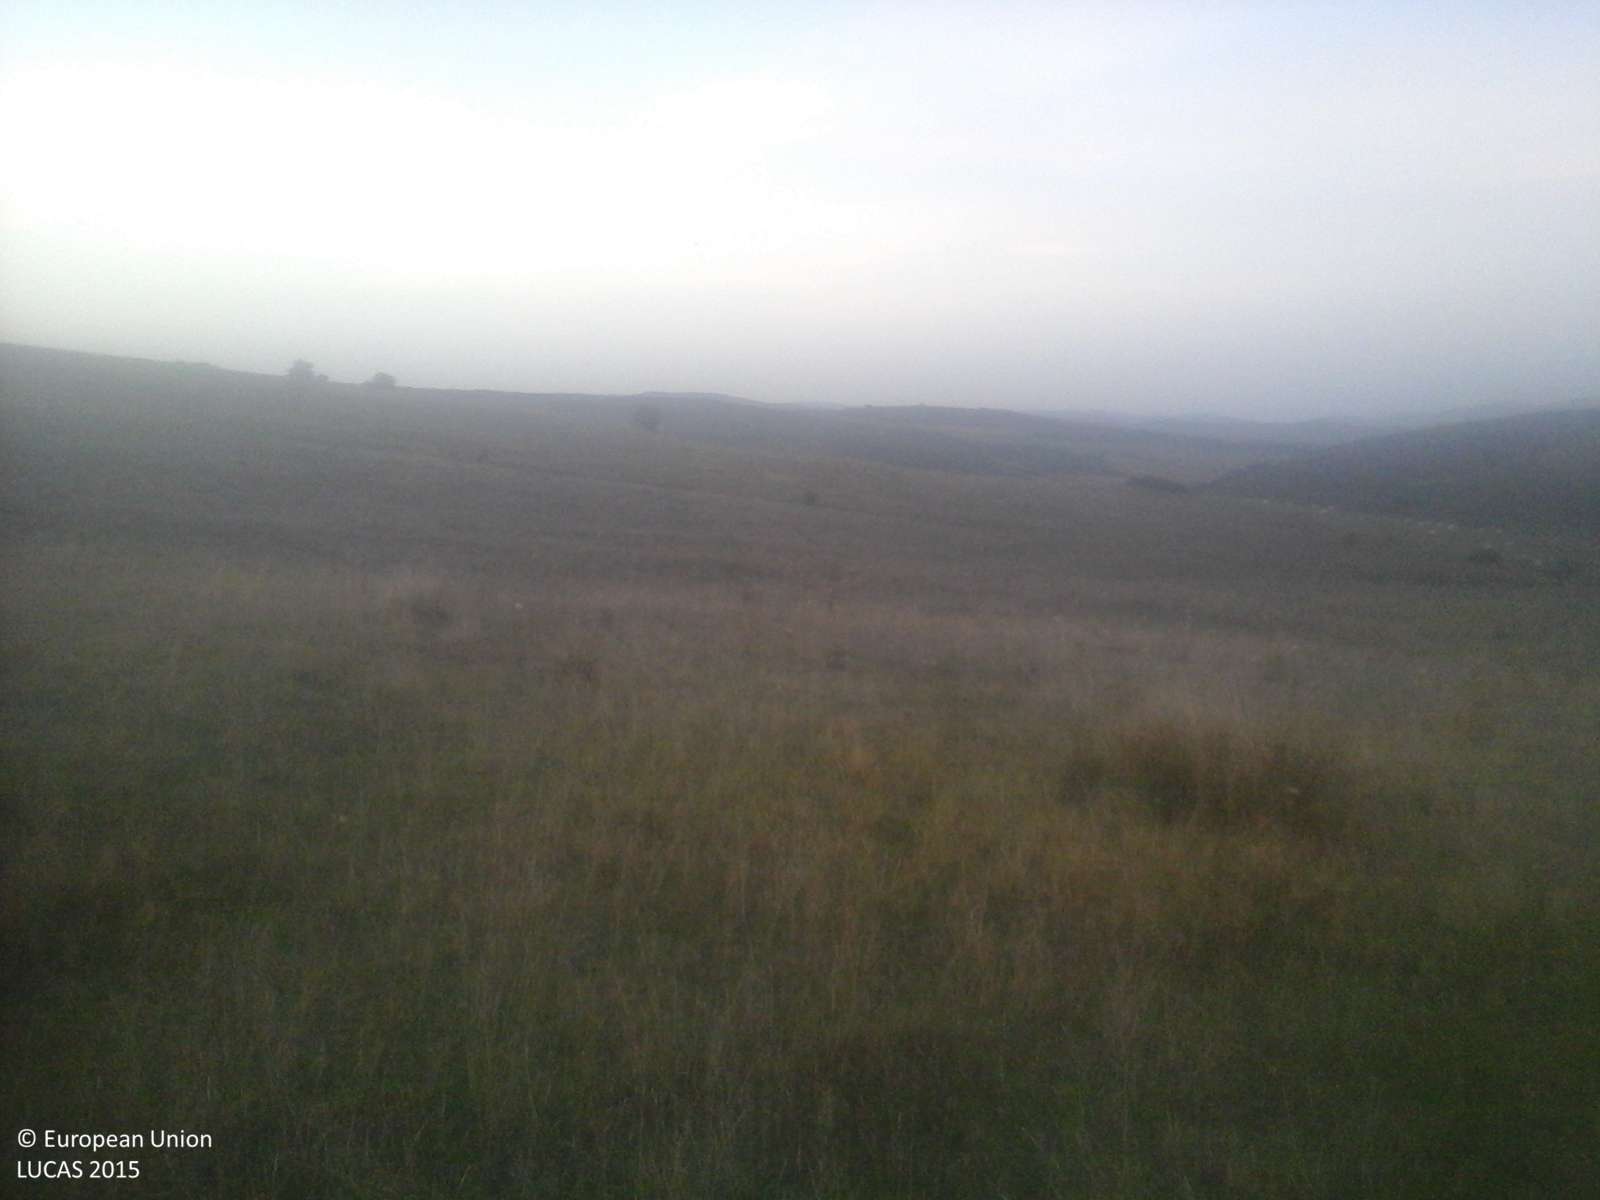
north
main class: Grassland
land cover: Grassland without tree/shrub cover
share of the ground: > 75 %
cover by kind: herbaceous plants 100 %
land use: Agriculture (excluding fallow land and kitchen gardens)
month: September
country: RO
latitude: 46.9329
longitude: 24.3376
